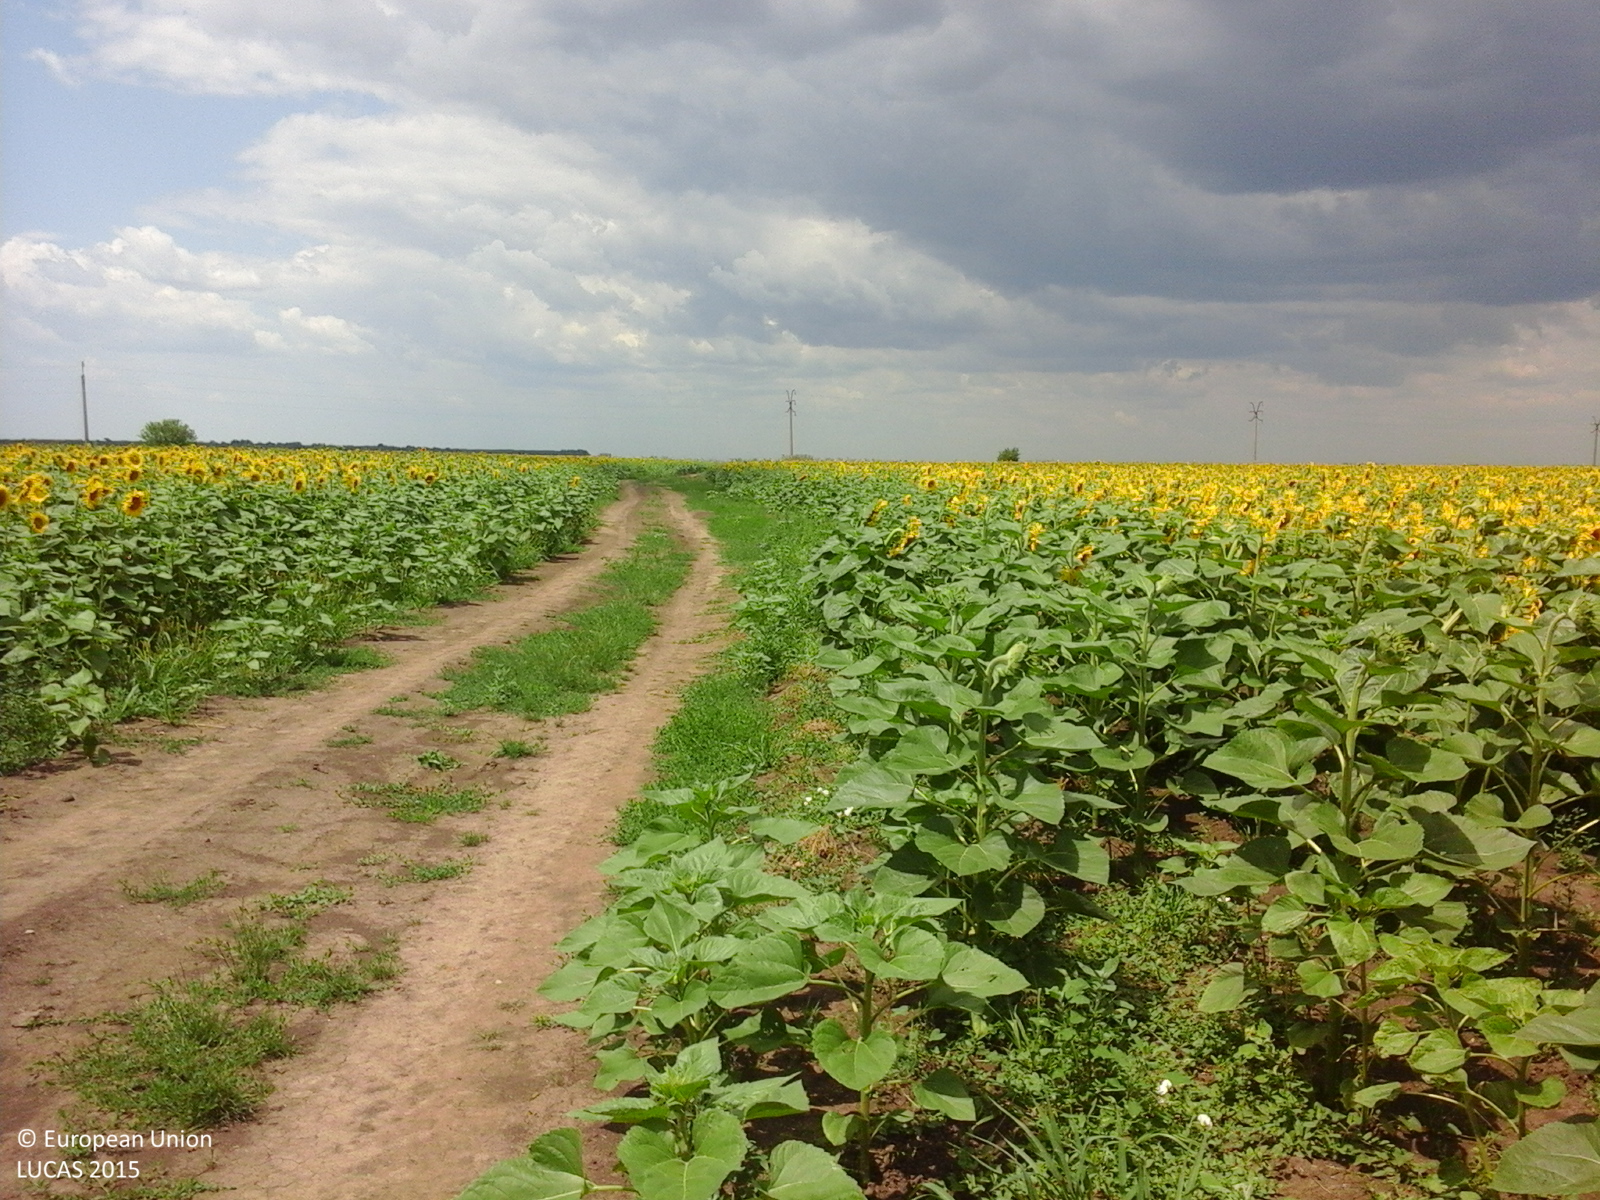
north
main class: Cropland
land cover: Sunflower
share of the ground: > 75 %
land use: Agriculture (excluding fallow land and kitchen gardens)
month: July
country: RO
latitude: 44.0389
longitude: 24.8870
